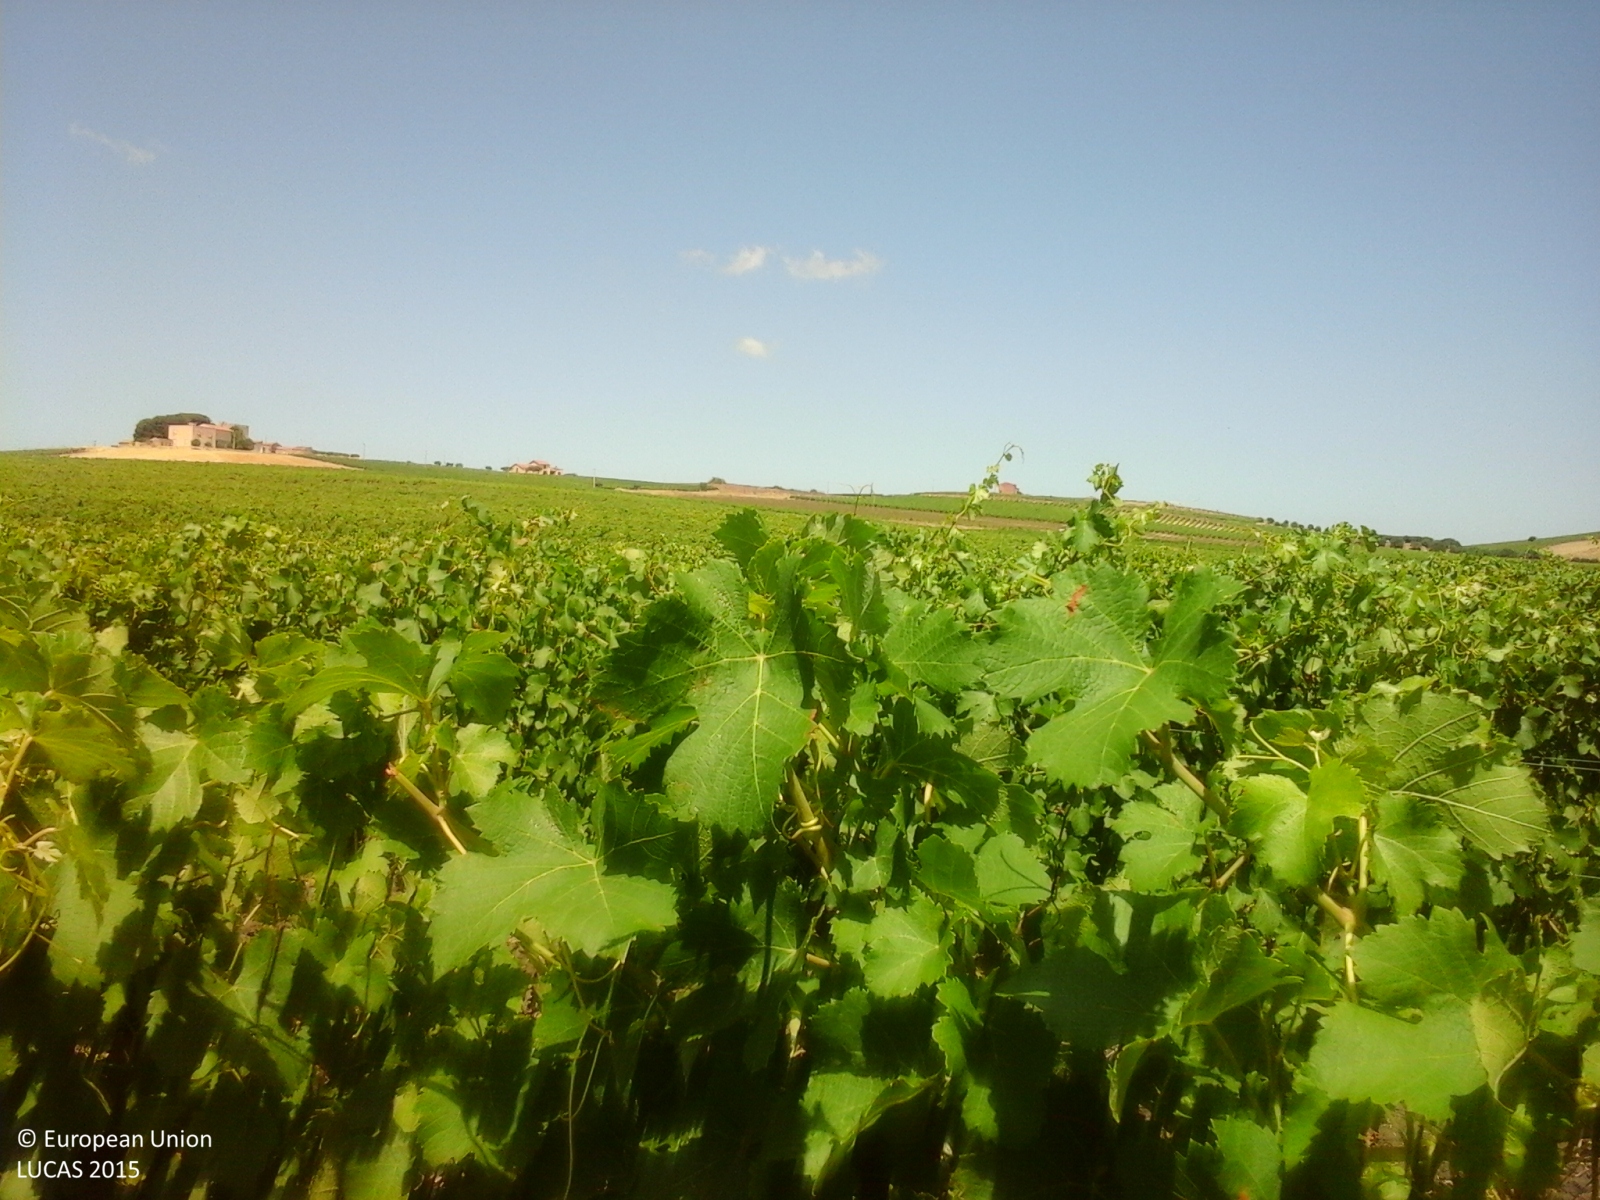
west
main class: Cropland
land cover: Vineyards
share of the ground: 25 - 50 %
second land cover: Other bare soil
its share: > 75 %
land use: Agriculture (excluding fallow land and kitchen gardens)
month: June
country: IT
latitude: 37.7639
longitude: 12.6929
